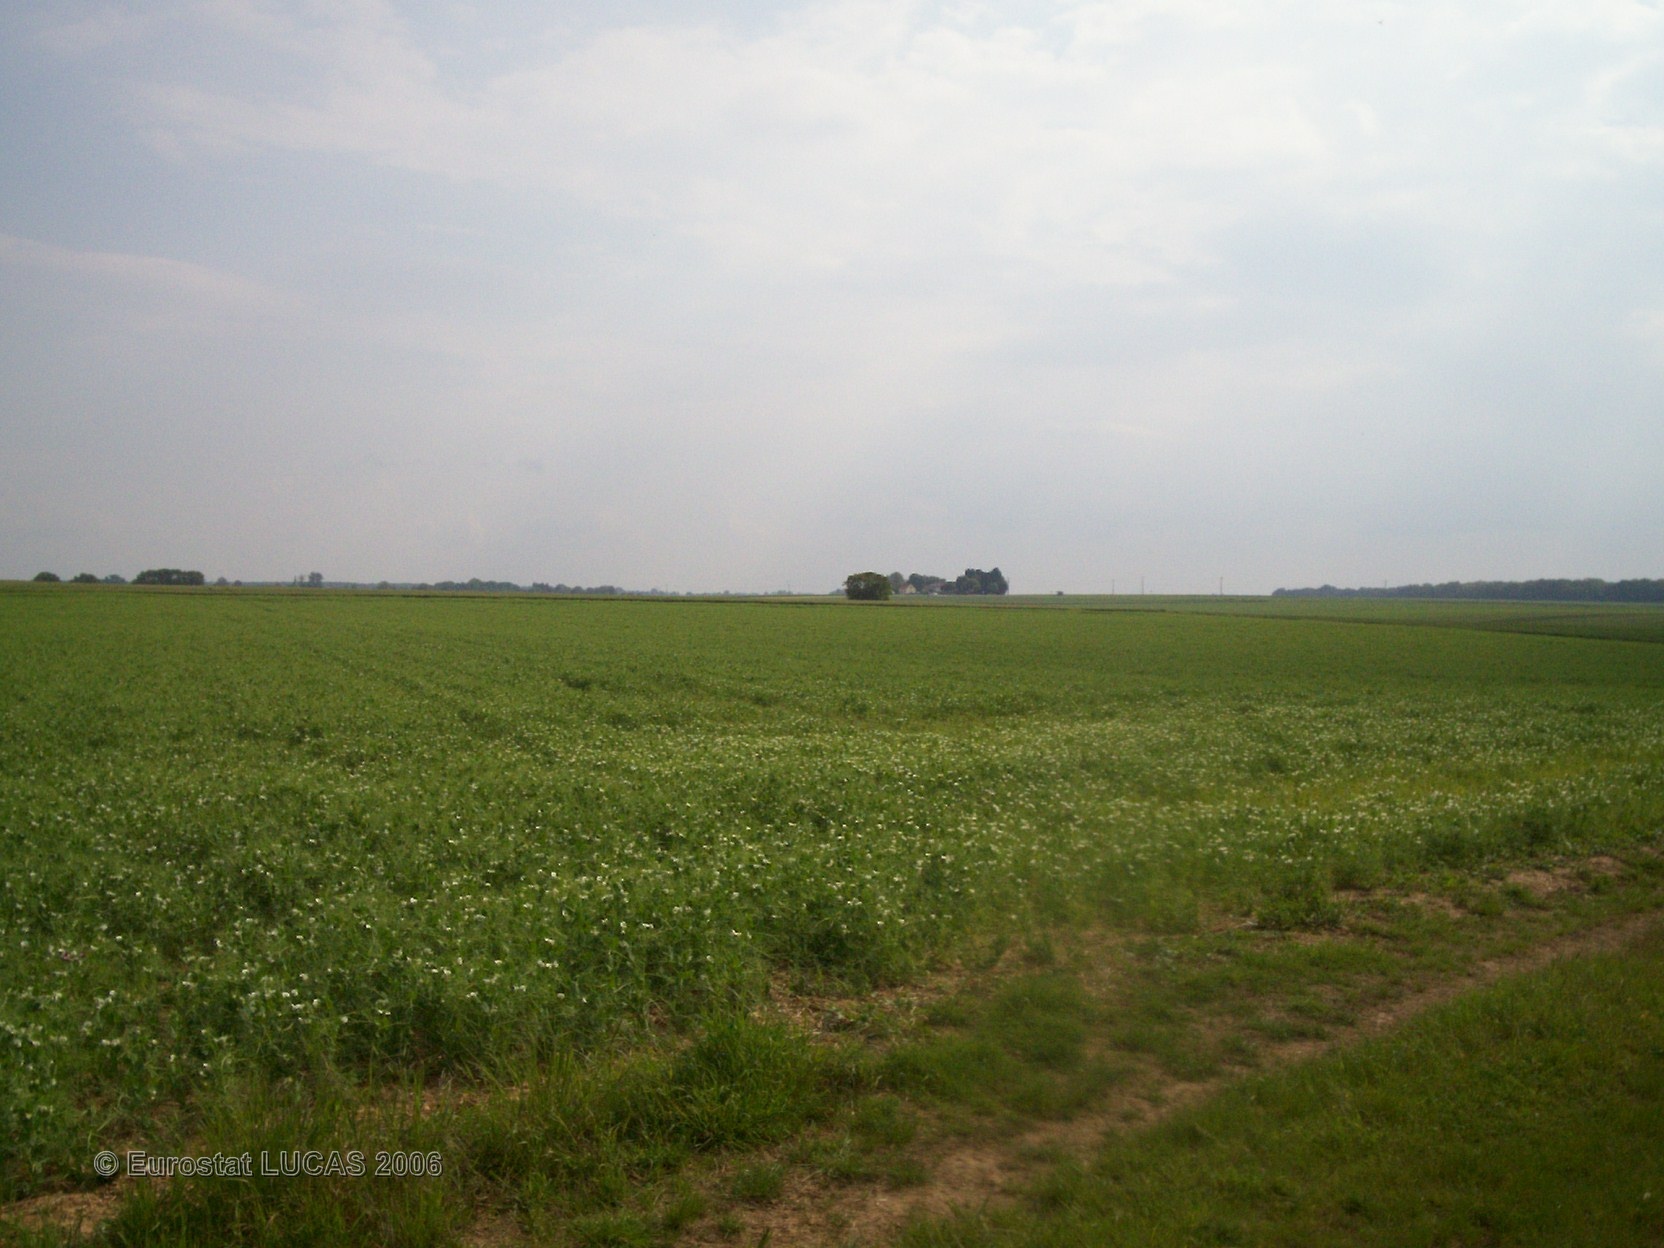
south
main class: Grassland
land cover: Grassland with sparse tree/shrub cover
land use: Railway transport
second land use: Transport via pipelines
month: June
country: FR
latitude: 49.6604
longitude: 2.6881
